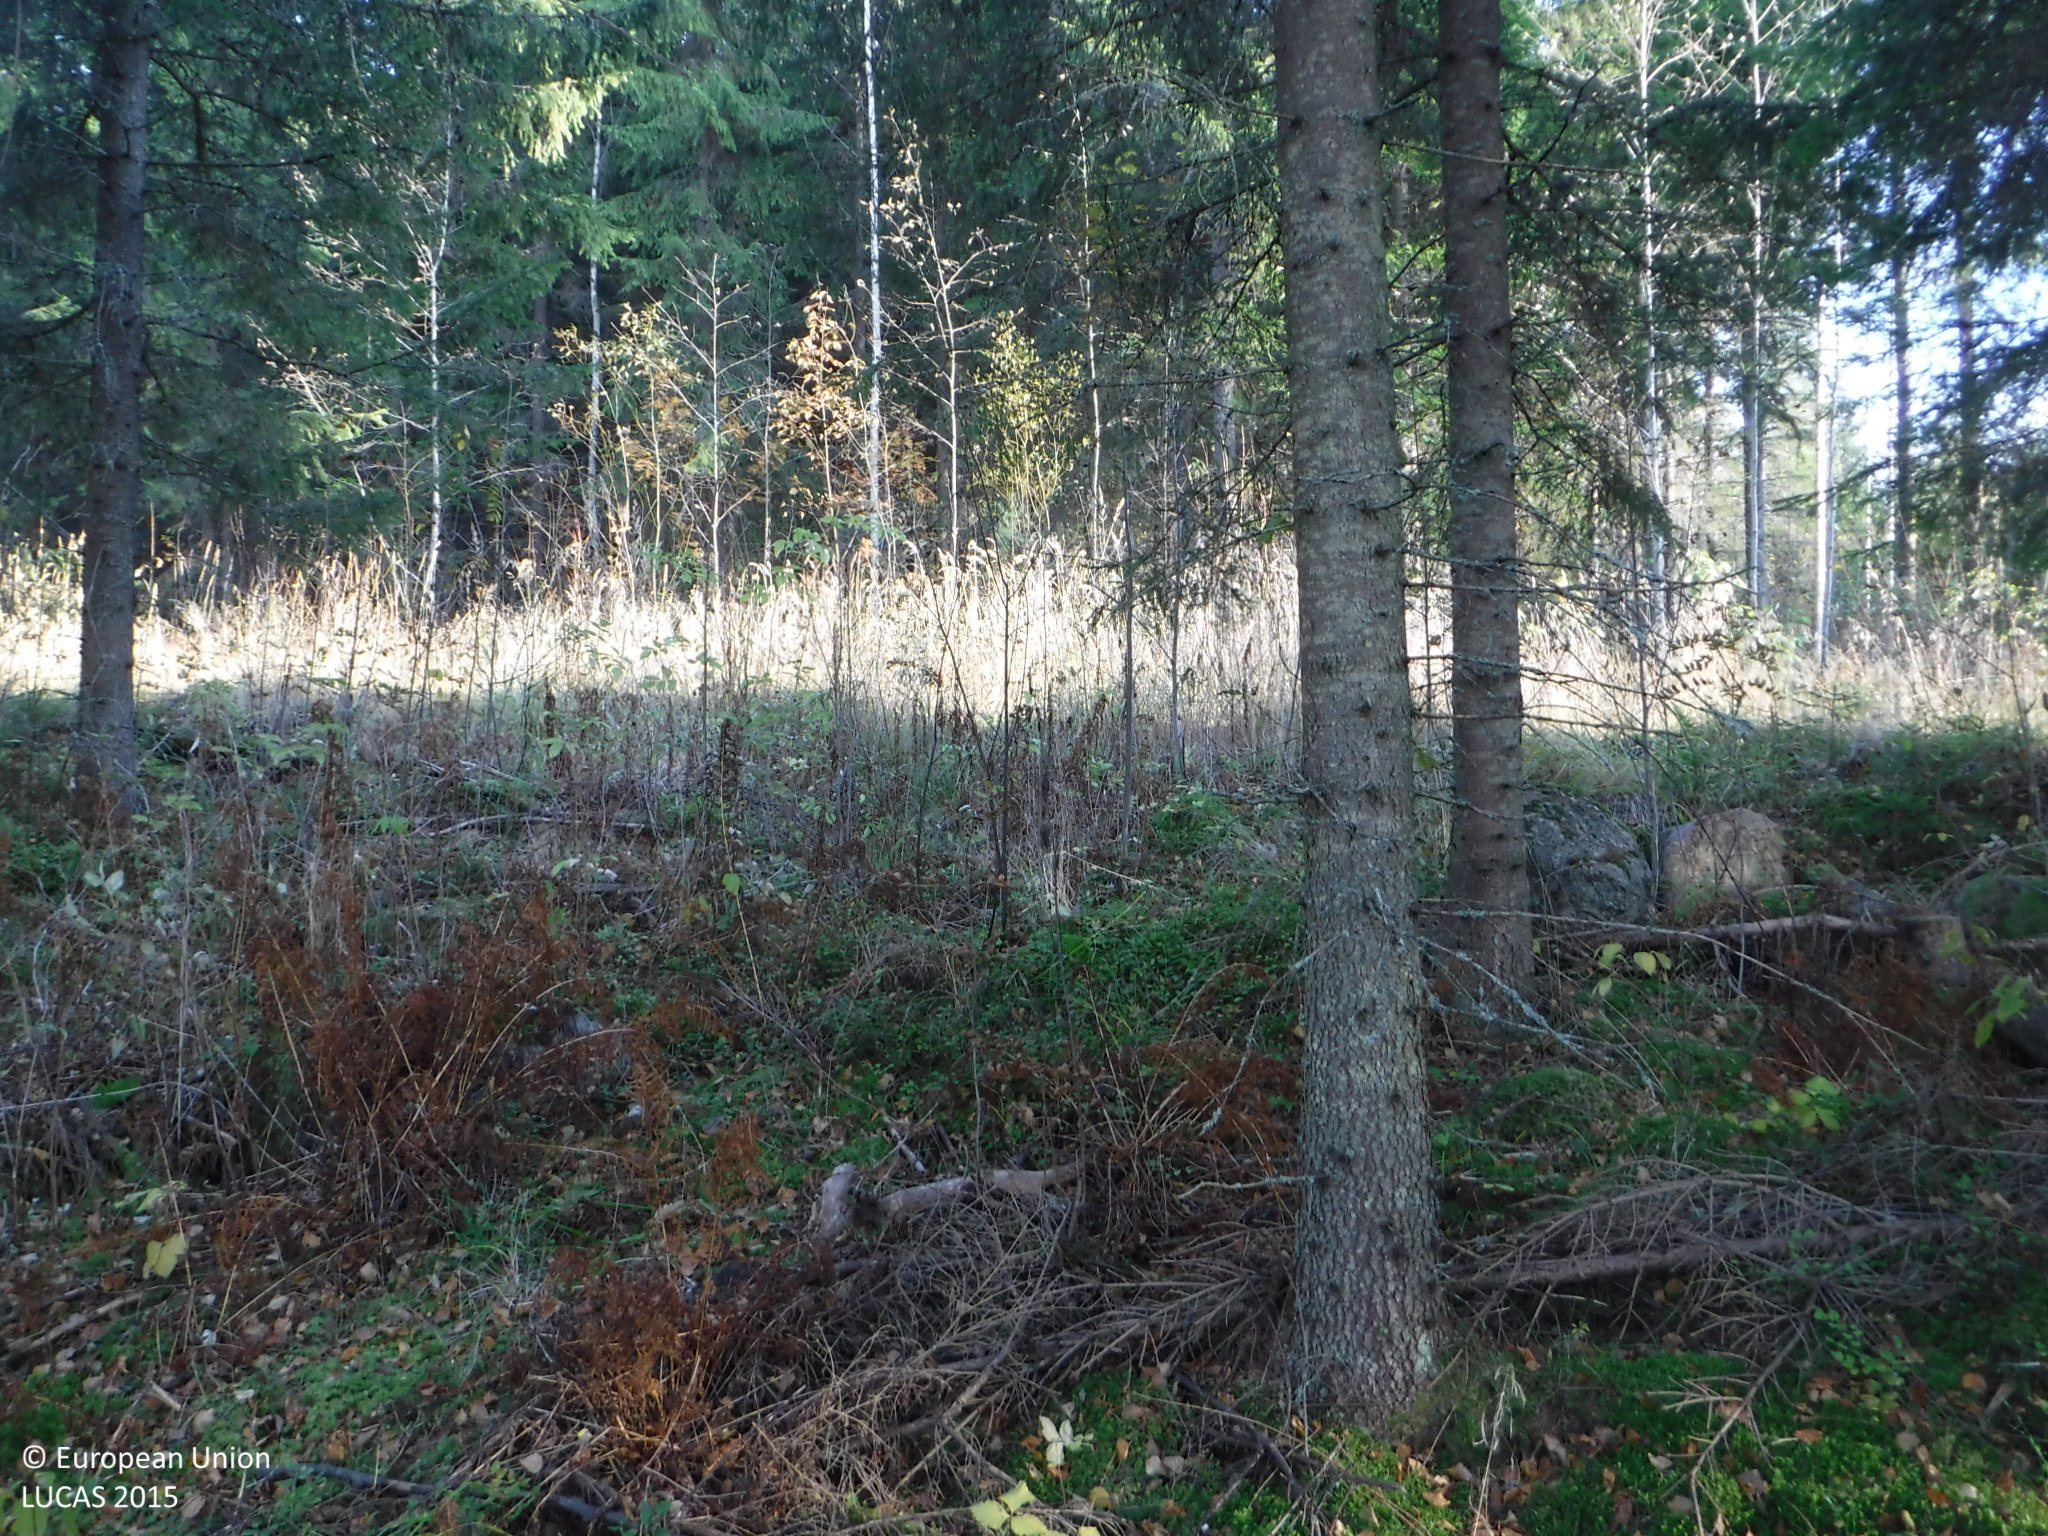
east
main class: Woodland
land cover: Spruce dominated mixed woodland
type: boreal forest
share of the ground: > 75 %
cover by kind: coniferous forest trees 45 %, broadleaved forest trees 35 %, lichens and mosses 15 %, shrubs 5 %
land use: Forestry
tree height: > 5 m
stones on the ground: > 50 %
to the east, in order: Spruce dominated mixed woodland; Shruby margins; Tracks; Shruby margins; Ditches and canals; Groves; Spruce dominated coniferous woodland; Spruce dominated mixed woodland; Other mixed woodland
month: October
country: FI
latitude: 62.0498
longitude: 25.9435
